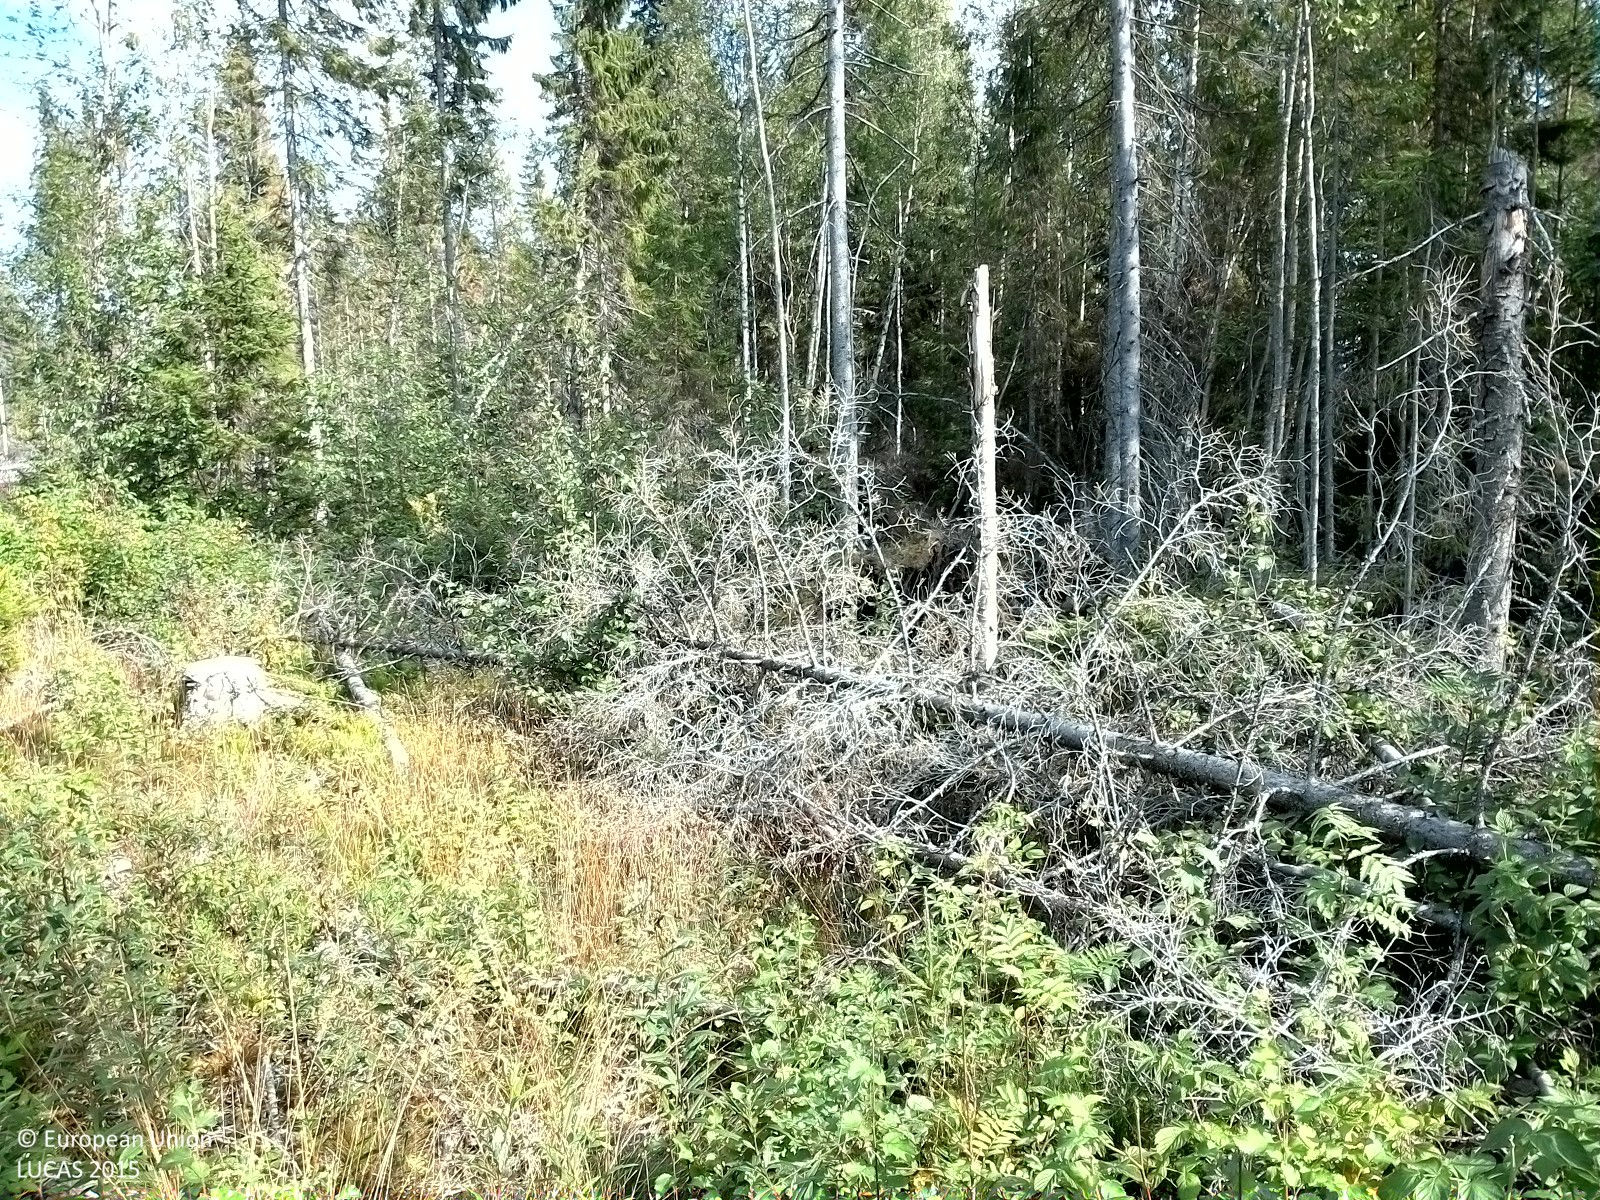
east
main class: Woodland
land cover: Spruce dominated mixed woodland
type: boreal forest
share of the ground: 25 - 50 %
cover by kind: herbaceous plants 55 %, broadleaved forest trees 20 %, coniferous forest trees 10 %, shrubs 5 %
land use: Forestry
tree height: > 5 m
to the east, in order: Spruce dominated mixed woodland; Other coniferous woodland; Spruce dominated coniferous woodland
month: August
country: SE
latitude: 62.4126
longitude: 16.1929
